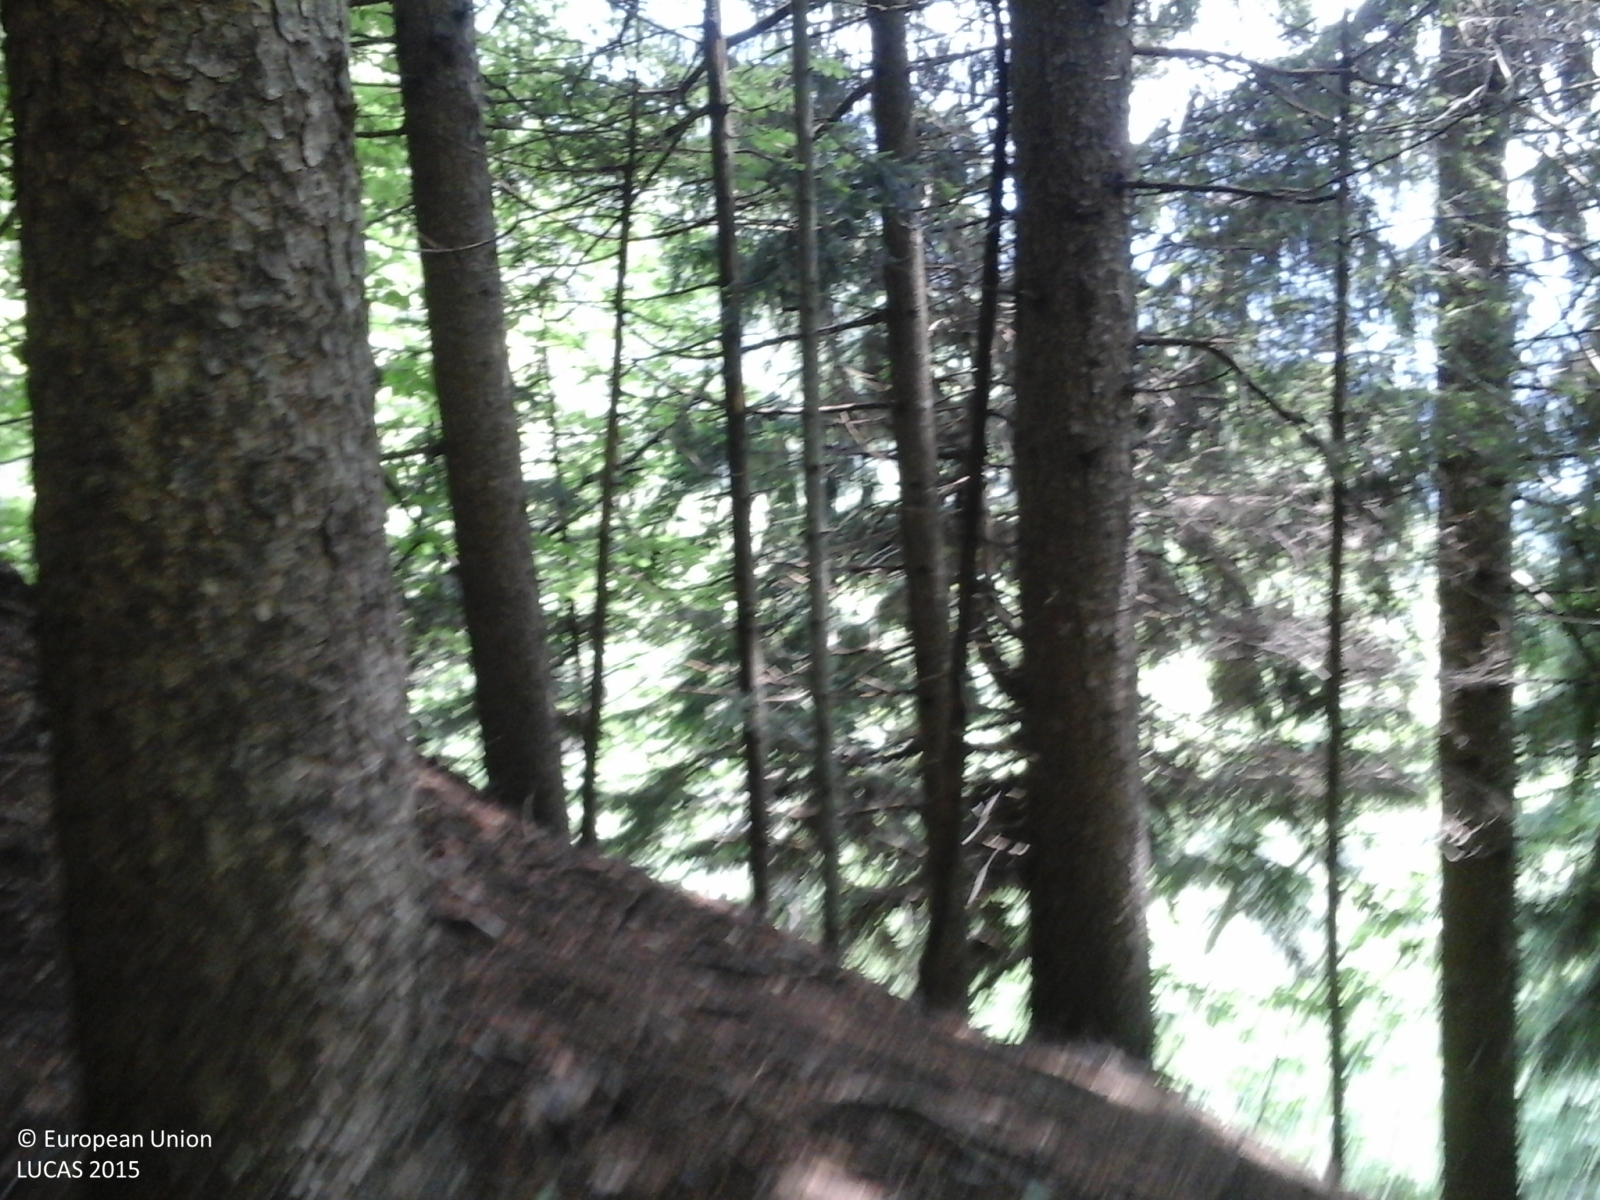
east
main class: Woodland
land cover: Spruce dominated mixed woodland
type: alpine coniferous forest
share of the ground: > 75 %
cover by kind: coniferous forest trees 75 %, broadleaved forest trees 25 %
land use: Forestry
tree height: > 5 m
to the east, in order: Spruce dominated mixed woodland; Rivers and streams; Spruce dominated mixed woodland; Spruce dominated coniferous woodland
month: May
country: IT
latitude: 46.2125
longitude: 11.6440
